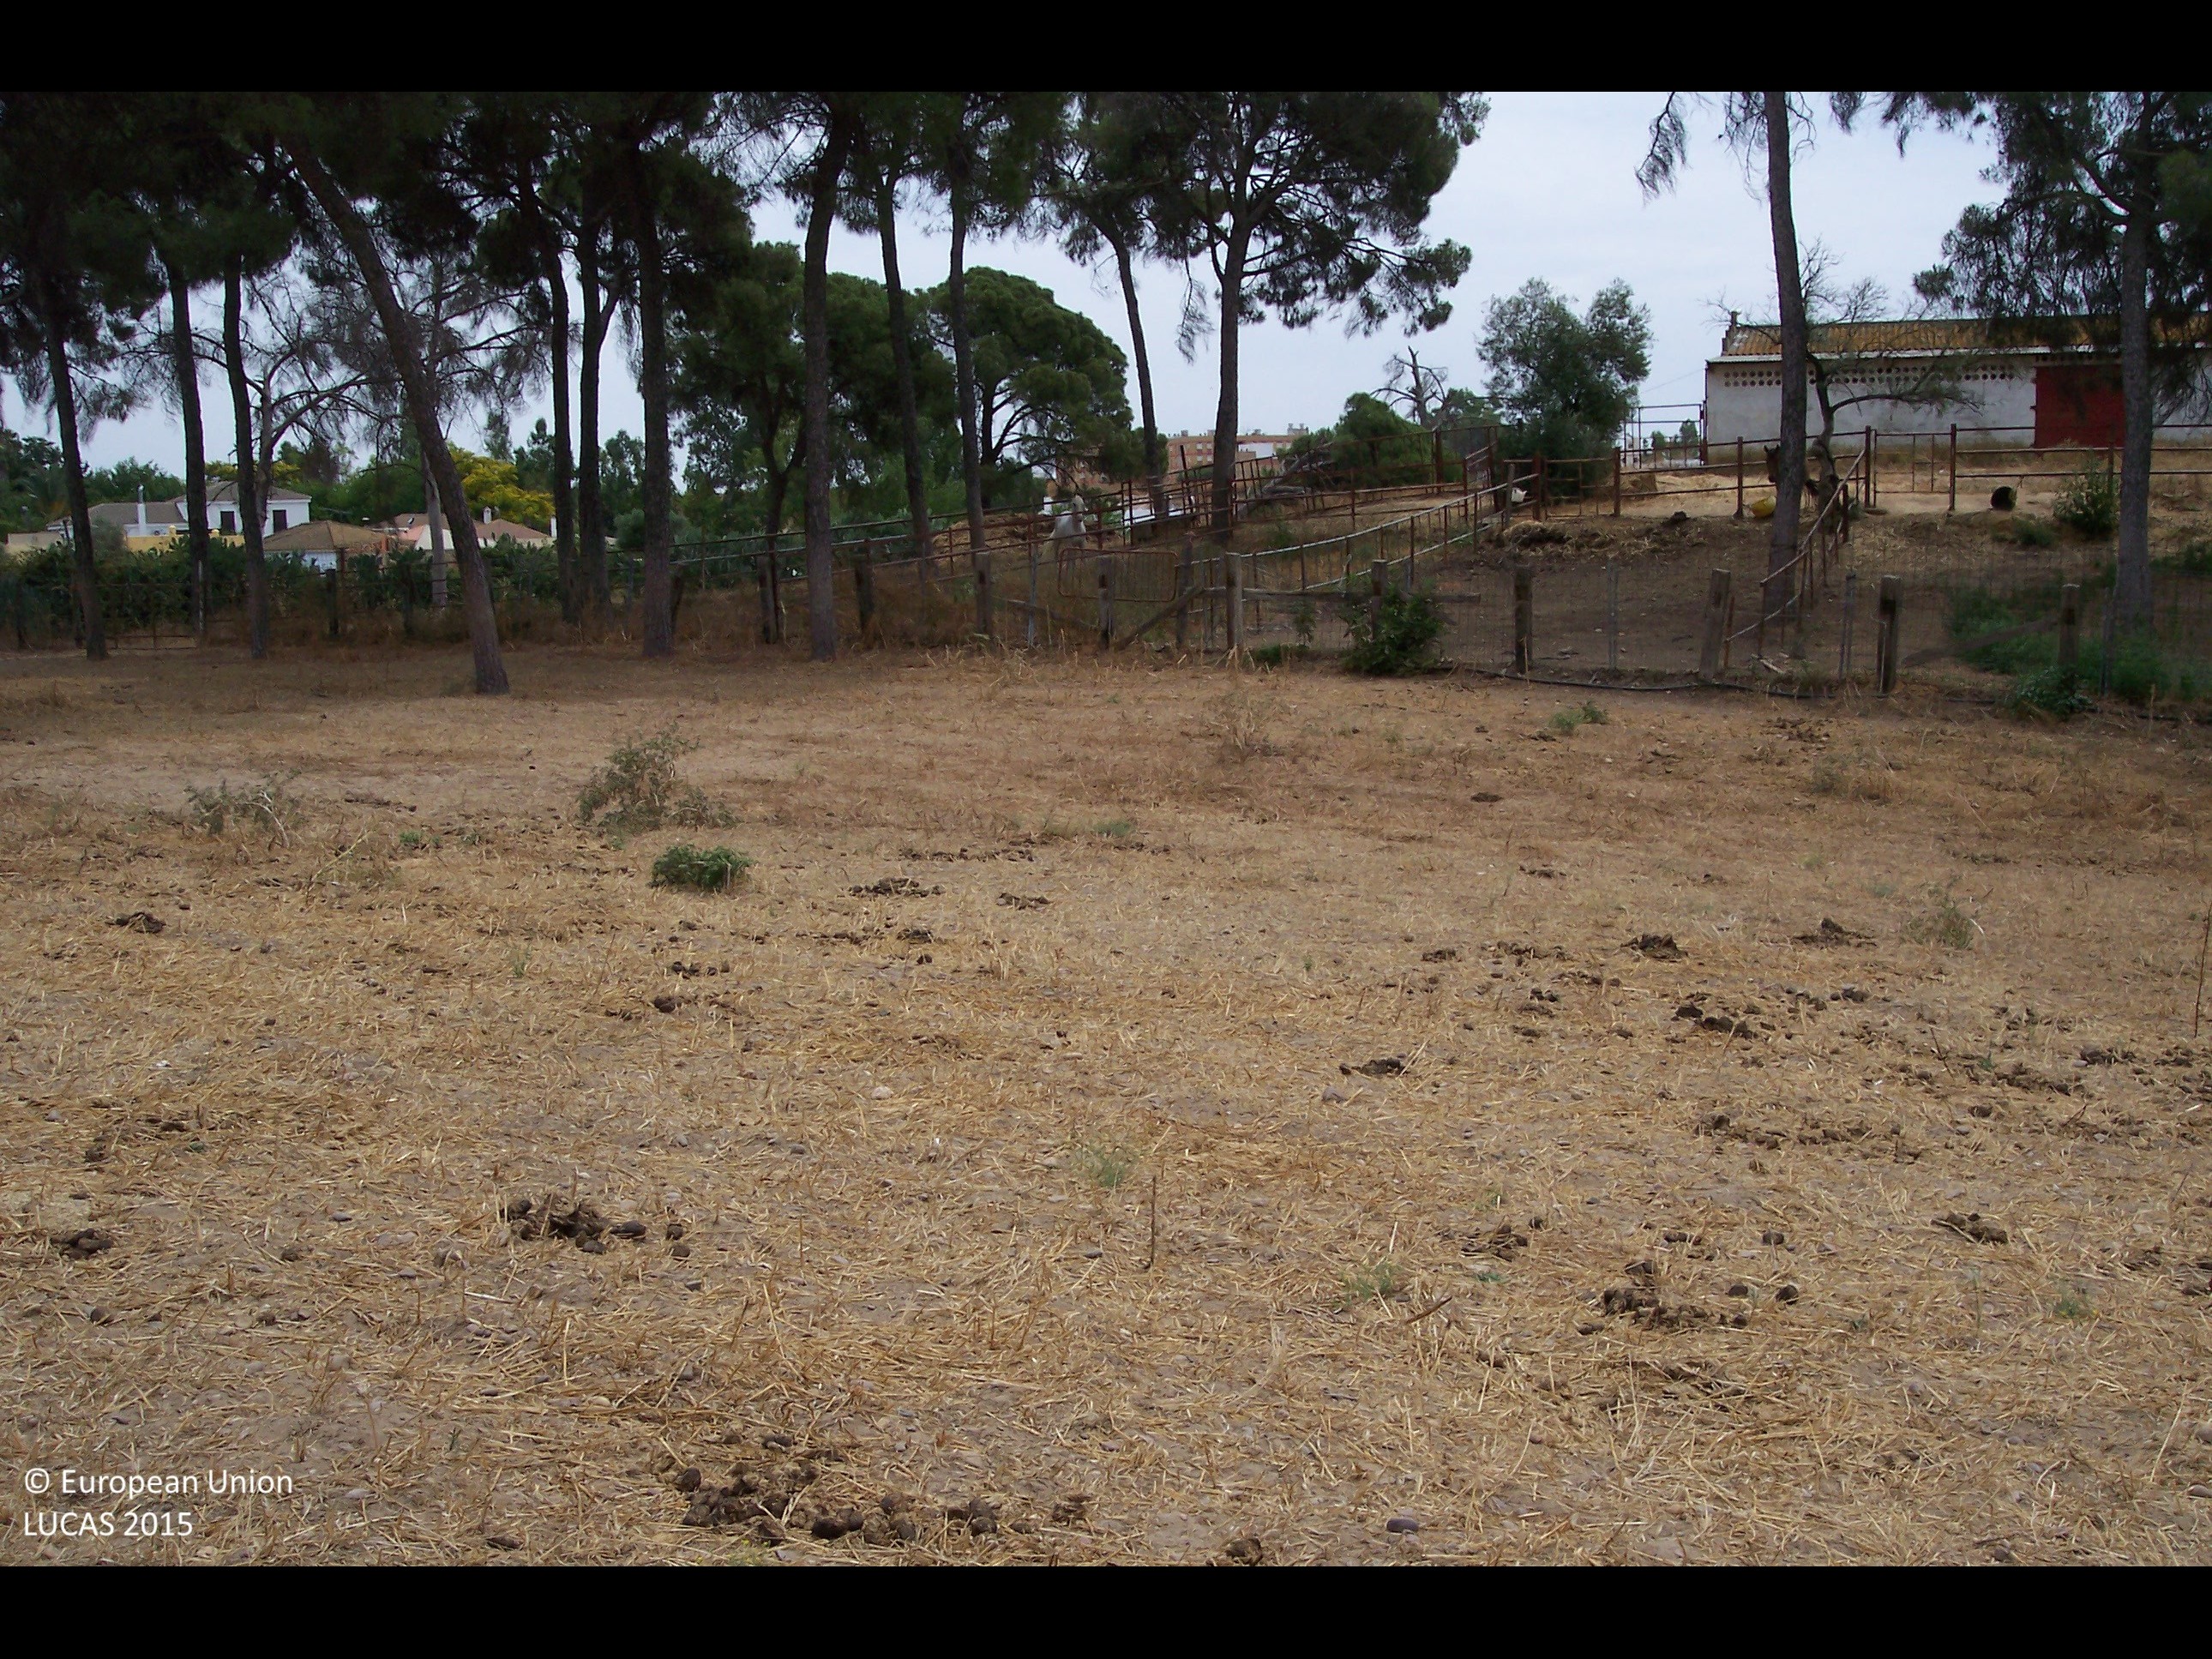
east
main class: Woodland
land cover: Pine dominated coniferous woodland
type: coniferous forest of the mediterranean region
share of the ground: 10 - 25 %
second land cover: Grassland without tree/shrub cover
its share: 50 - 75 %
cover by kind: herbaceous plants 90 %, coniferous forest trees 10 %
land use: Forestry
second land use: Agriculture (excluding fallow land and kitchen gardens)
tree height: > 5 m
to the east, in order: Pine dominated coniferous woodland; Grassland without tree/shrub cover; Fences; Pine dominated coniferous woodland; Shruby margins; Fences; Artificial constructions in urban areas; Fences; Shruby margins; Spontaneously vegetated surfaces
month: June
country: ES
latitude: 37.2747
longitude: -6.0710
